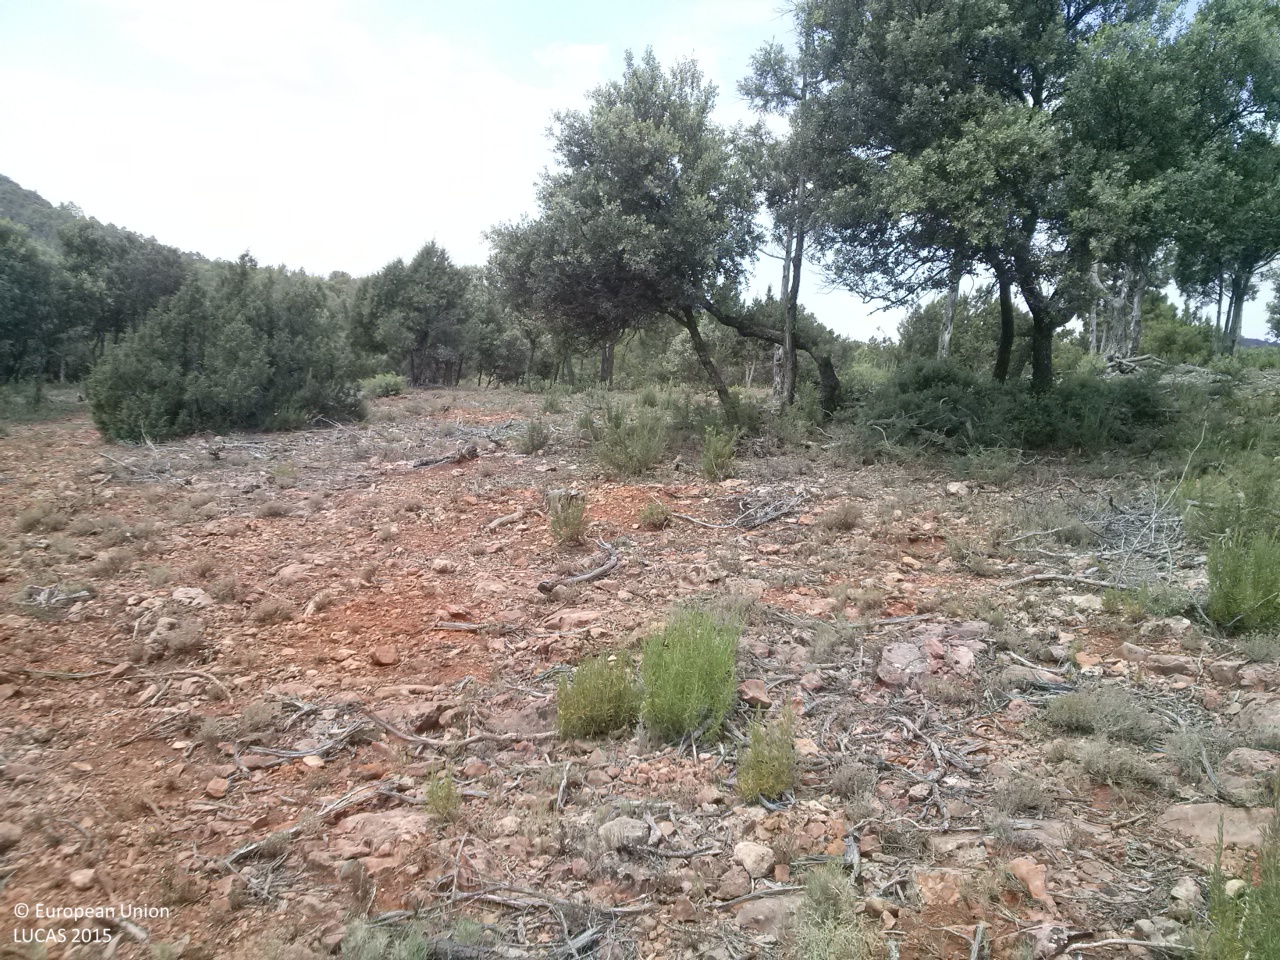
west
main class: Woodland
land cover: Other mixed woodland
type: broadleaved evergreen forest
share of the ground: 25 - 50 %
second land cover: Grassland without tree/shrub cover
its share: 25 - 50 %
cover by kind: herbaceous plants 30 %, broadleaved forest trees 20 %, shrubs 20 %, unconsolidated bare surface 20 %, coniferous forest trees 10 %
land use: Forestry
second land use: Agriculture (excluding fallow land and kitchen gardens)
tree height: < 5 m
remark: Clear cut
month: June
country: ES
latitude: 39.9931
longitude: -1.7825
